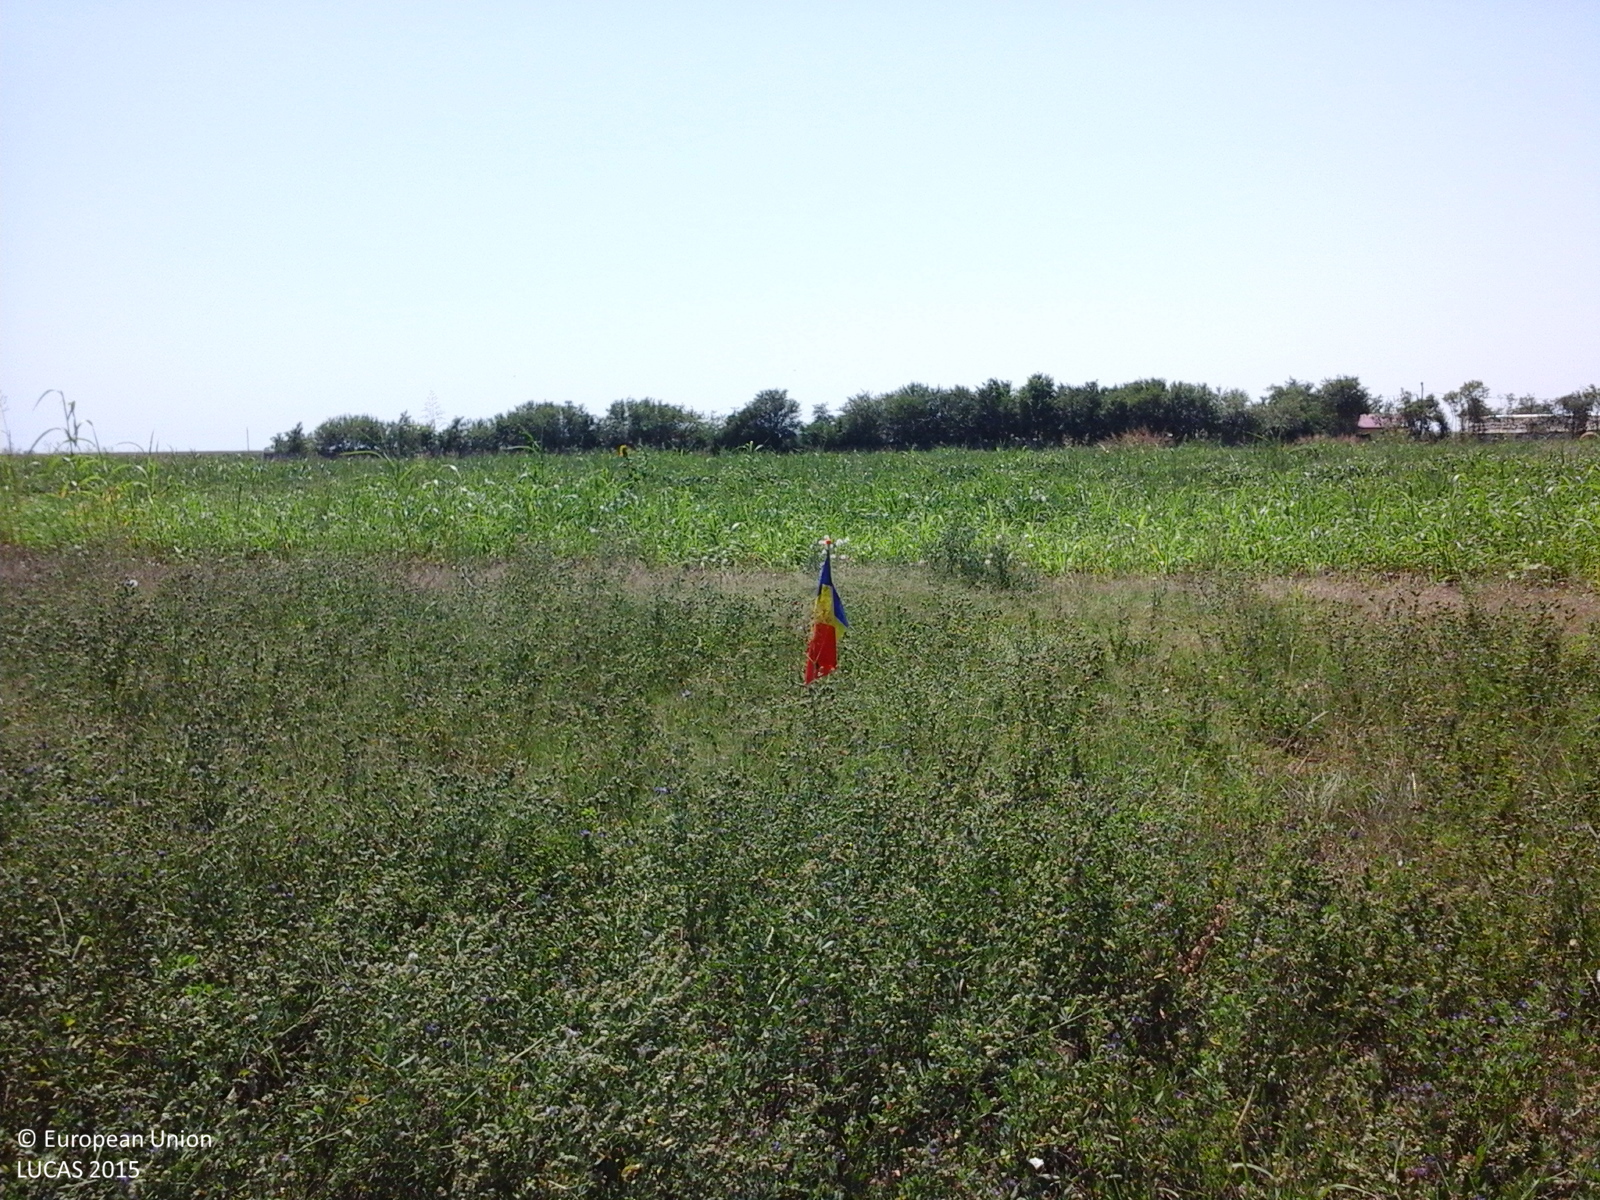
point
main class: Cropland
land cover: Lucerne
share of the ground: > 75 %
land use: Agriculture (excluding fallow land and kitchen gardens)
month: July
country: RO
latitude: 45.0517
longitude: 27.2186
